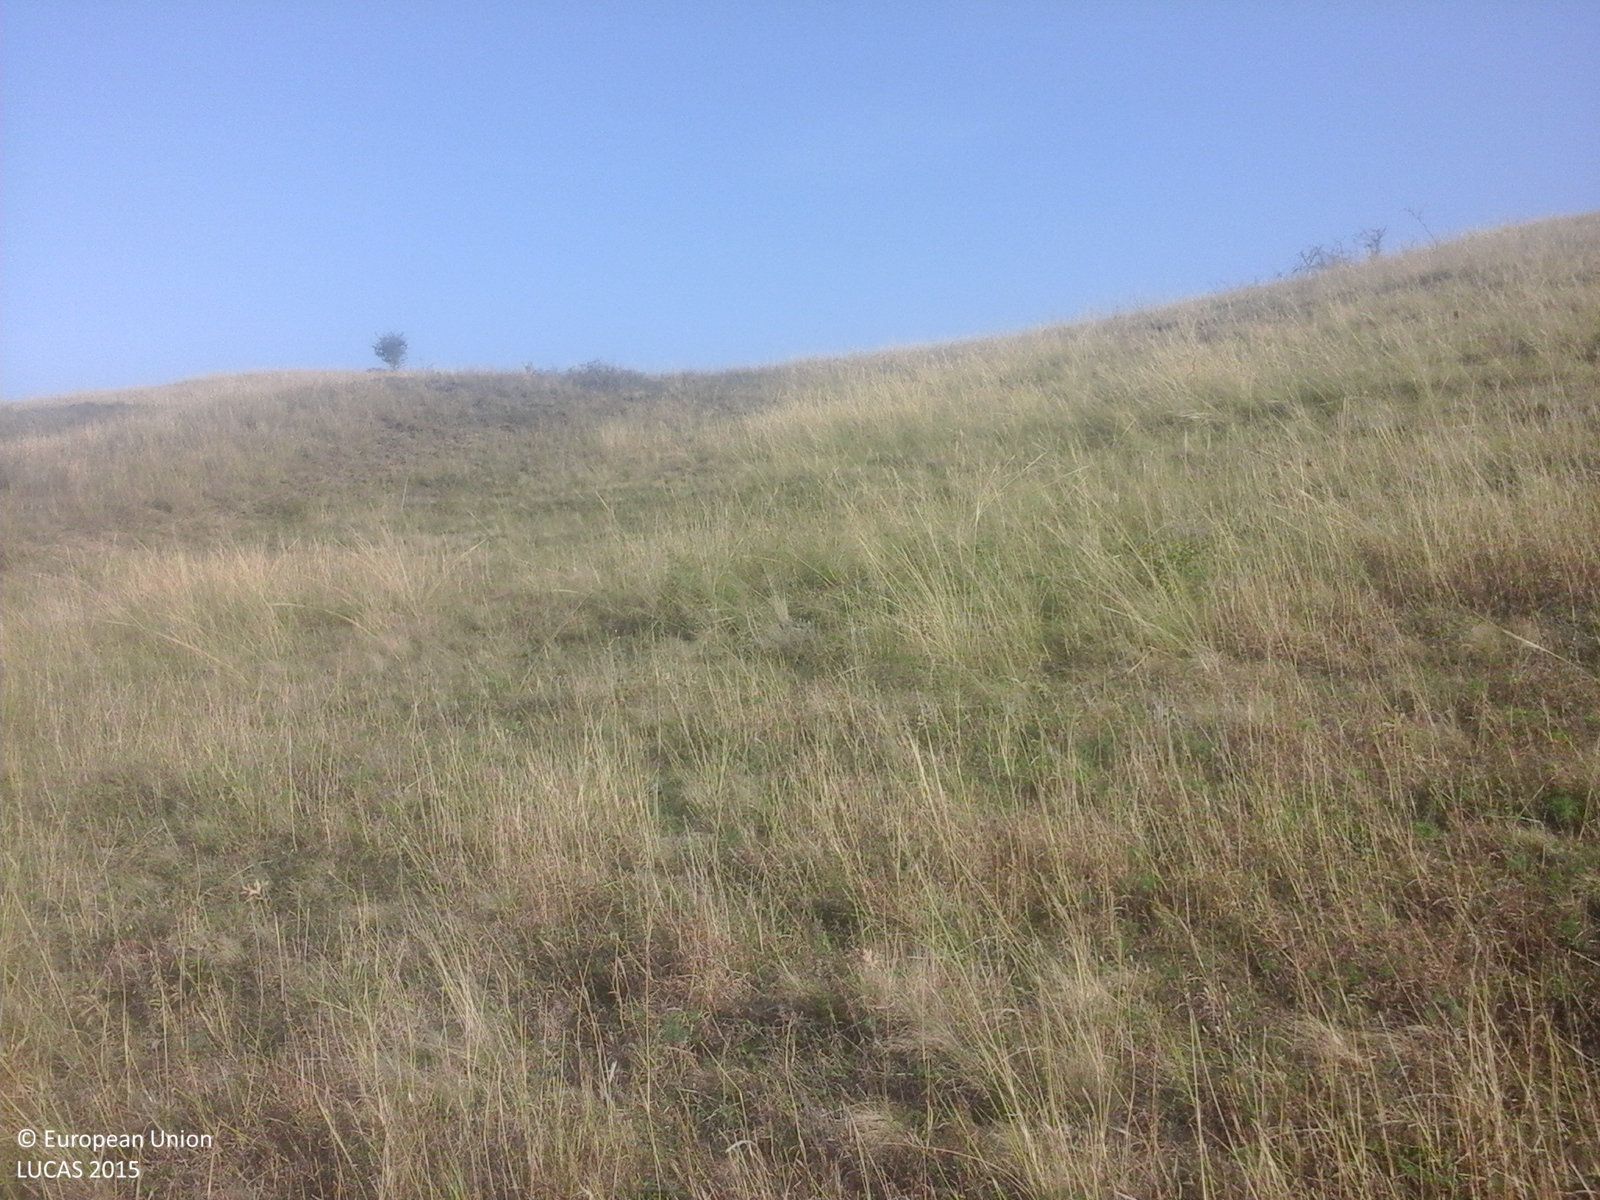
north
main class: Grassland
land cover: Grassland without tree/shrub cover
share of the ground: > 75 %
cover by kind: herbaceous plants 100 %
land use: Agriculture (excluding fallow land and kitchen gardens)
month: September
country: RO
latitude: 46.8306
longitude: 24.2826
